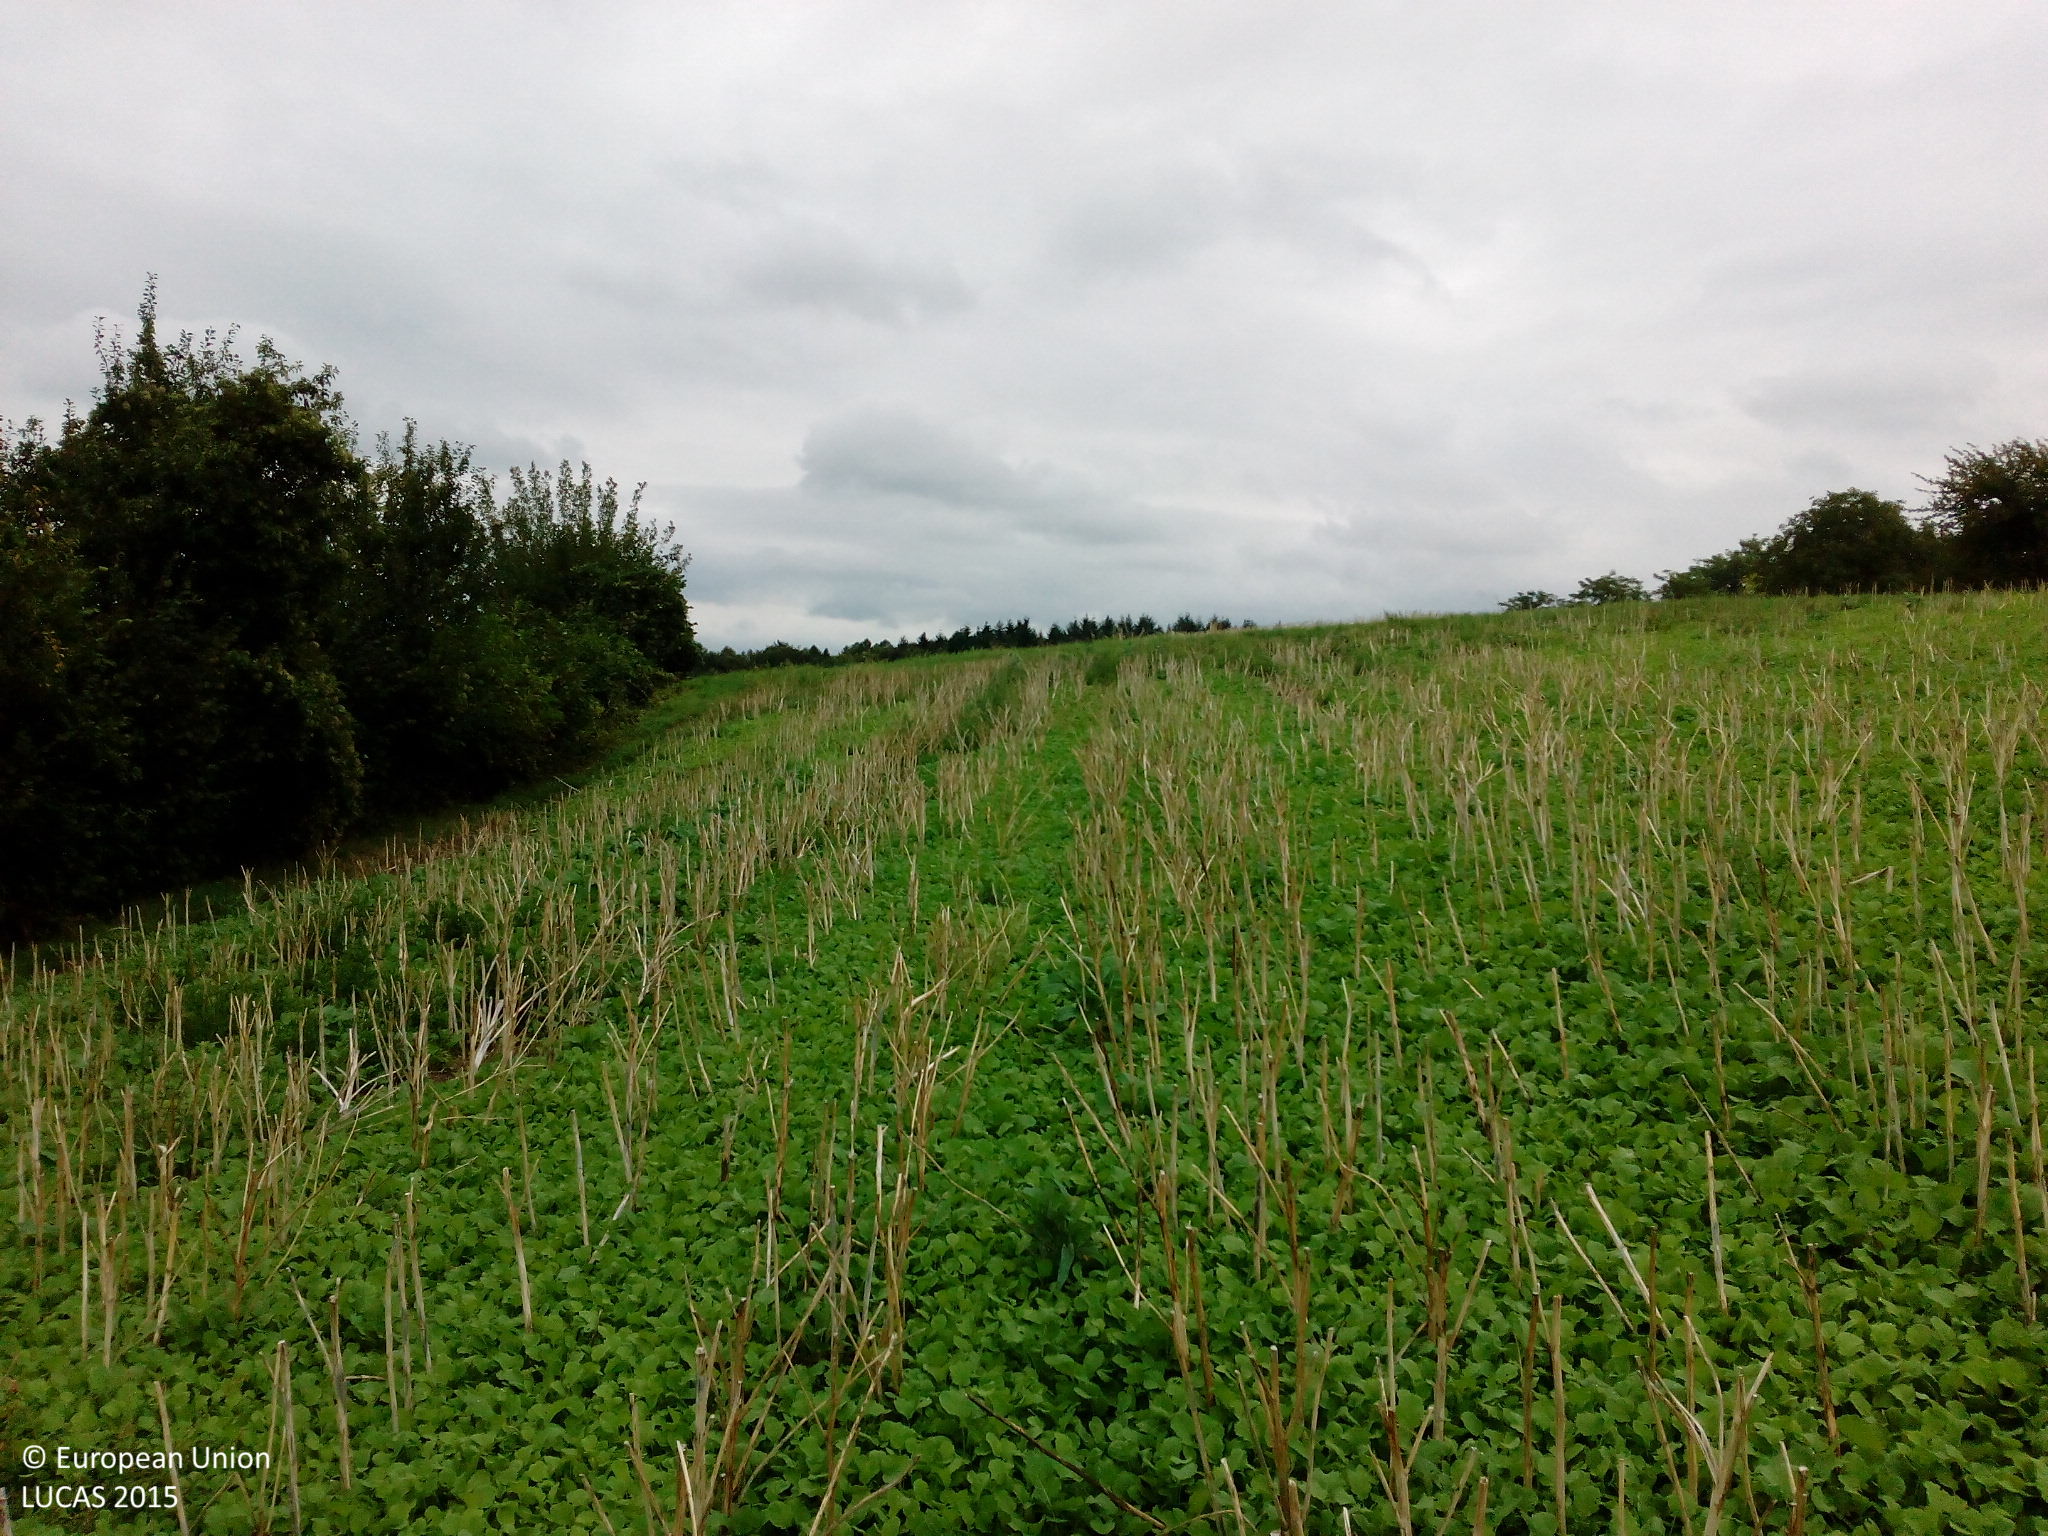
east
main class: Cropland
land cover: Rape and turnip rape
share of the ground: 10 - 25 %
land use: Agriculture (excluding fallow land and kitchen gardens)
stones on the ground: < 10 %
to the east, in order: Rape and turnip rape; Grassland without tree/shrub cover; Rape and turnip rape; Paved roads, cycling and walking lanes; Other bare soil
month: August
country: DE
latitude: 49.0599
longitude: 8.5636
